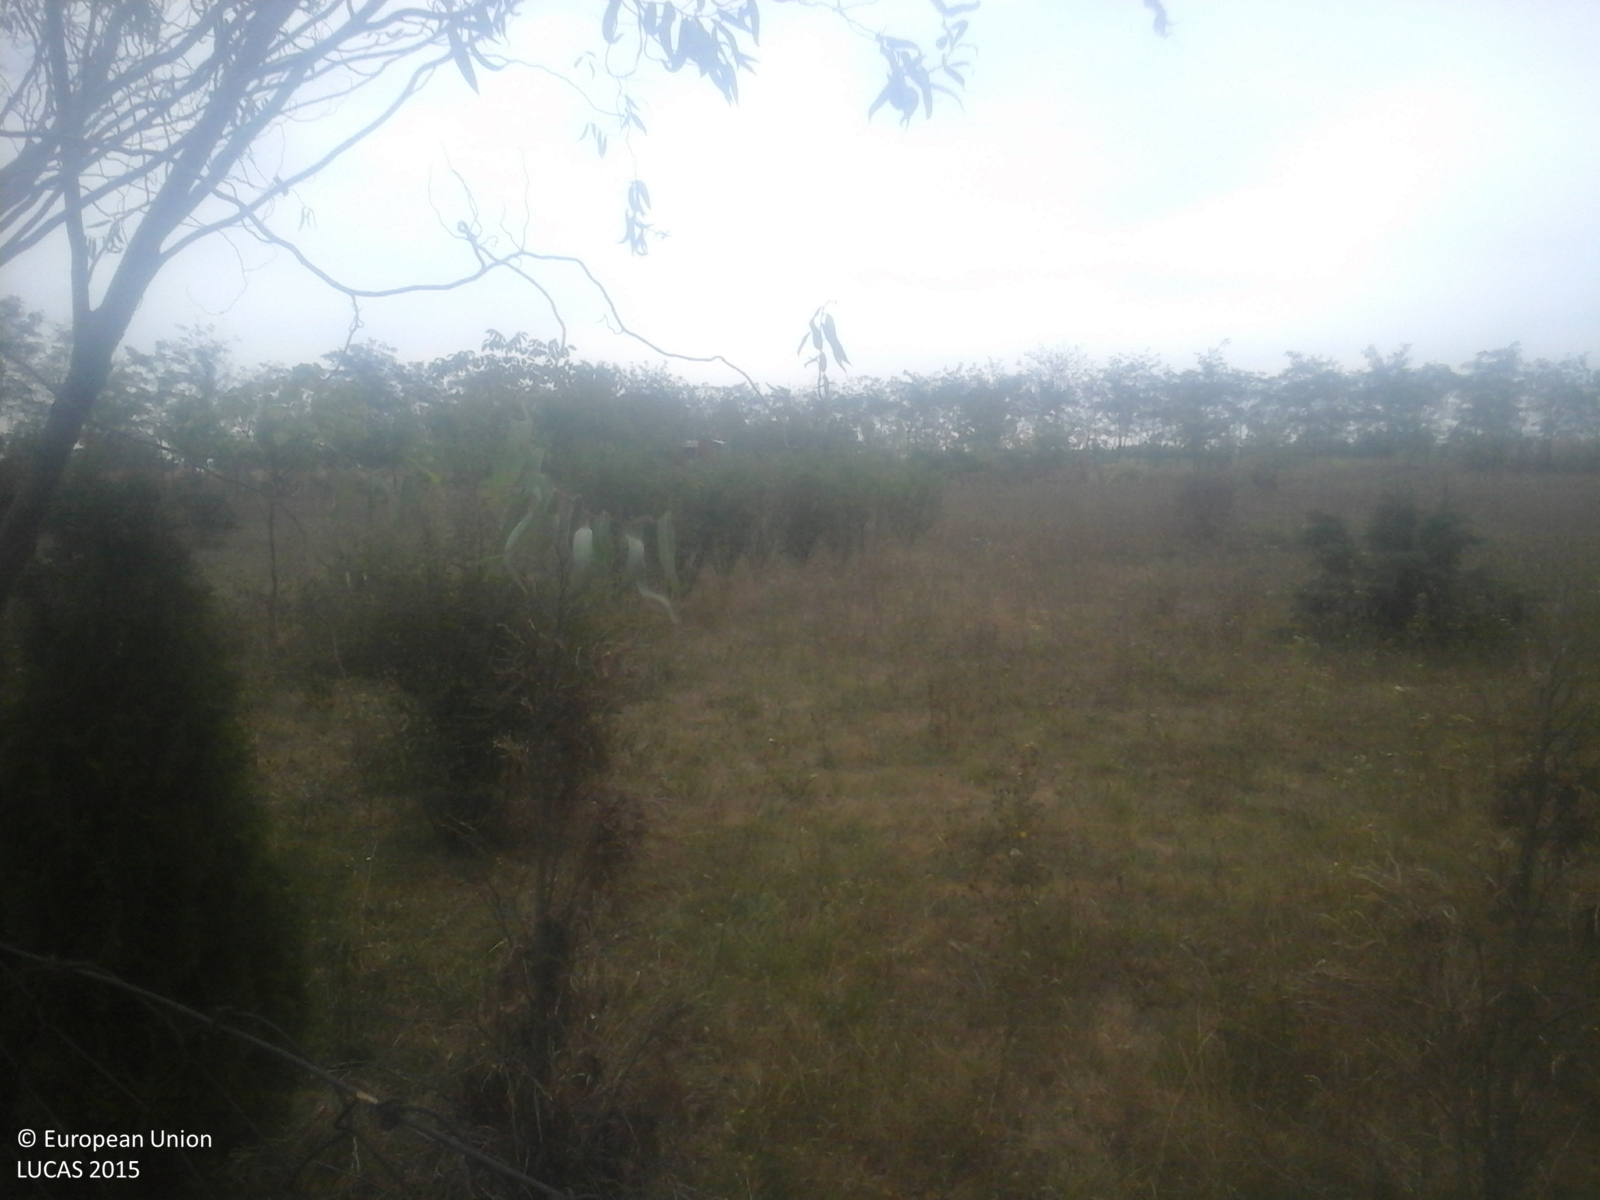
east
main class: Grassland
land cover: Grassland with sparse tree/shrub cover
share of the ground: > 75 %
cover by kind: herbaceous plants 85 %, shrubs 10 %, broadleaved forest trees 5 %
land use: Agriculture (excluding fallow land and kitchen gardens)
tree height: < 5 m
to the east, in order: Grassland with sparse tree/shrub cover; Fences; Lines of trees; Common wheat; Grass margins; Tracks; Grass margins; Fences; Abandoned hedges; Other fruit trees and berries
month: September
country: RO
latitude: 47.6597
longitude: 22.4539
